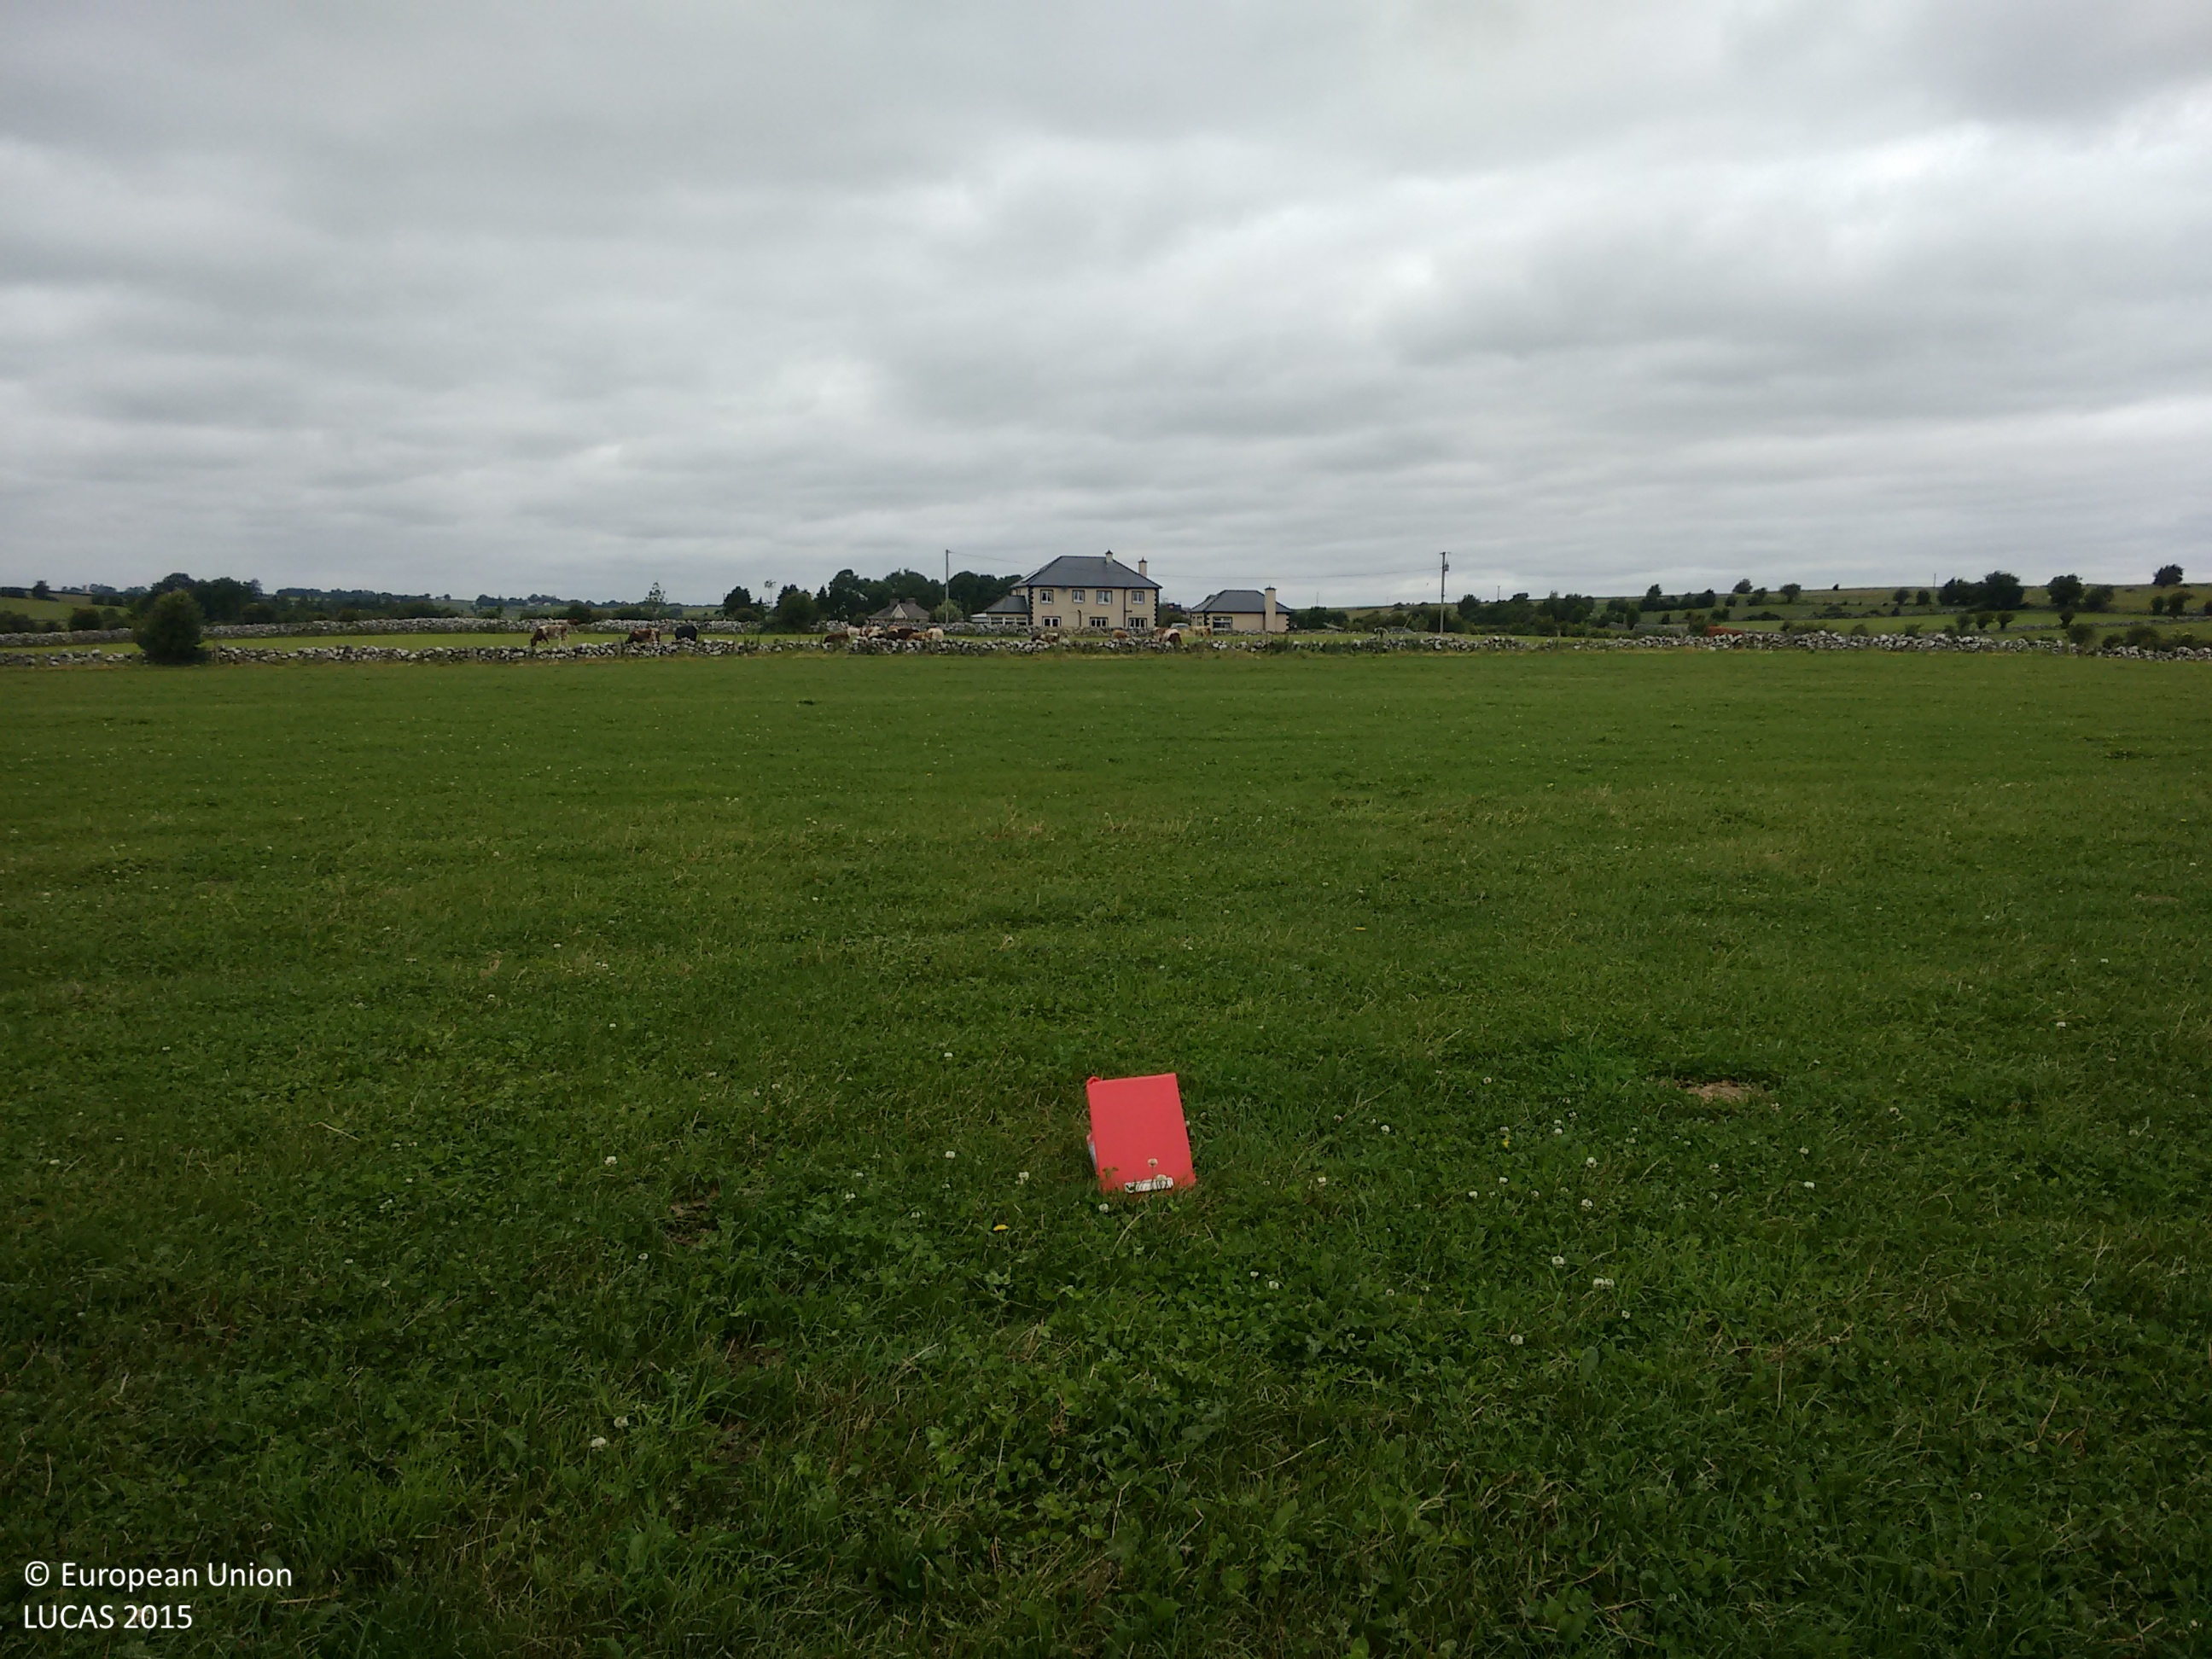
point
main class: Grassland
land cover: Grassland without tree/shrub cover
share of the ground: > 75 %
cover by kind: herbaceous plants 100 %
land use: Agriculture (excluding fallow land and kitchen gardens)
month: July
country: IE
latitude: 53.7096
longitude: -8.1640
